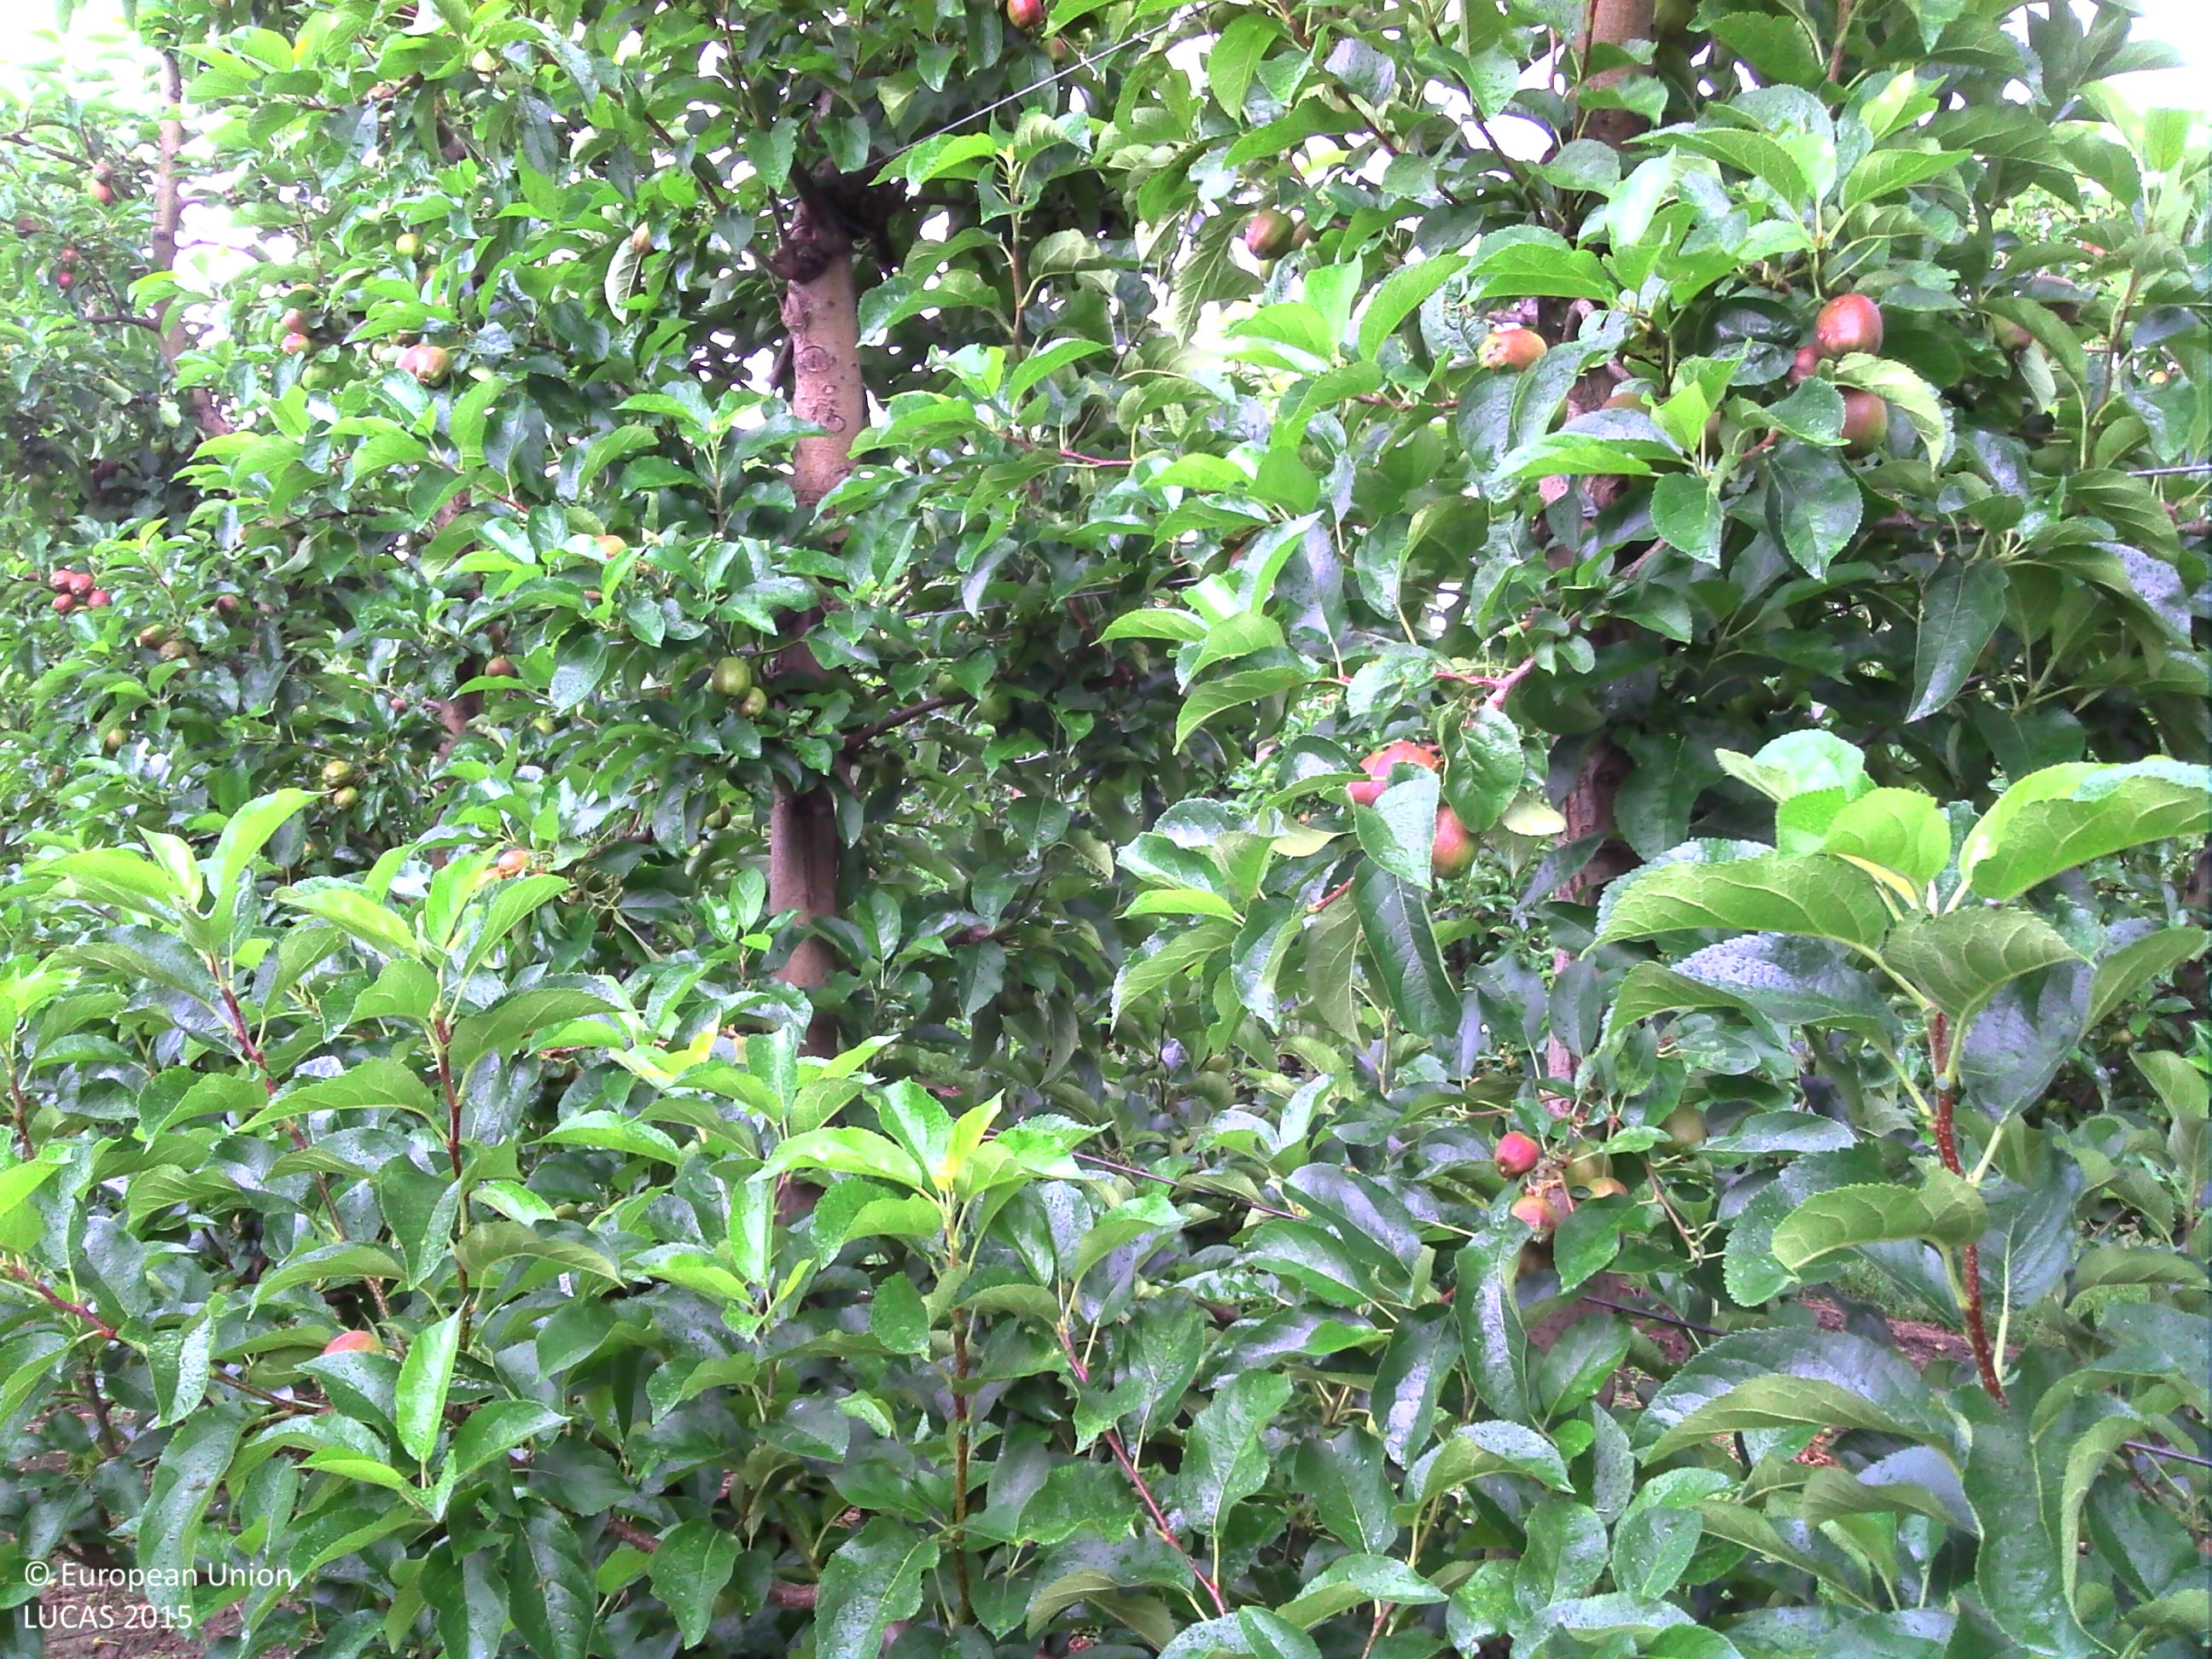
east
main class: Cropland
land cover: Apple fruit
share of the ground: 50 - 75 %
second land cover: Grassland without tree/shrub cover
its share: 25 - 50 %
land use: Agriculture (excluding fallow land and kitchen gardens)
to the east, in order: Apple fruit; Grassland without tree/shrub cover; Electric lines; Ditches and canals; Grass margins; Paved roads, cycling and walking lanes; Artificial constructions in urban areas; Tracks; Grass margins; Maize
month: June
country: BE
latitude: 50.8964
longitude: 5.2631
